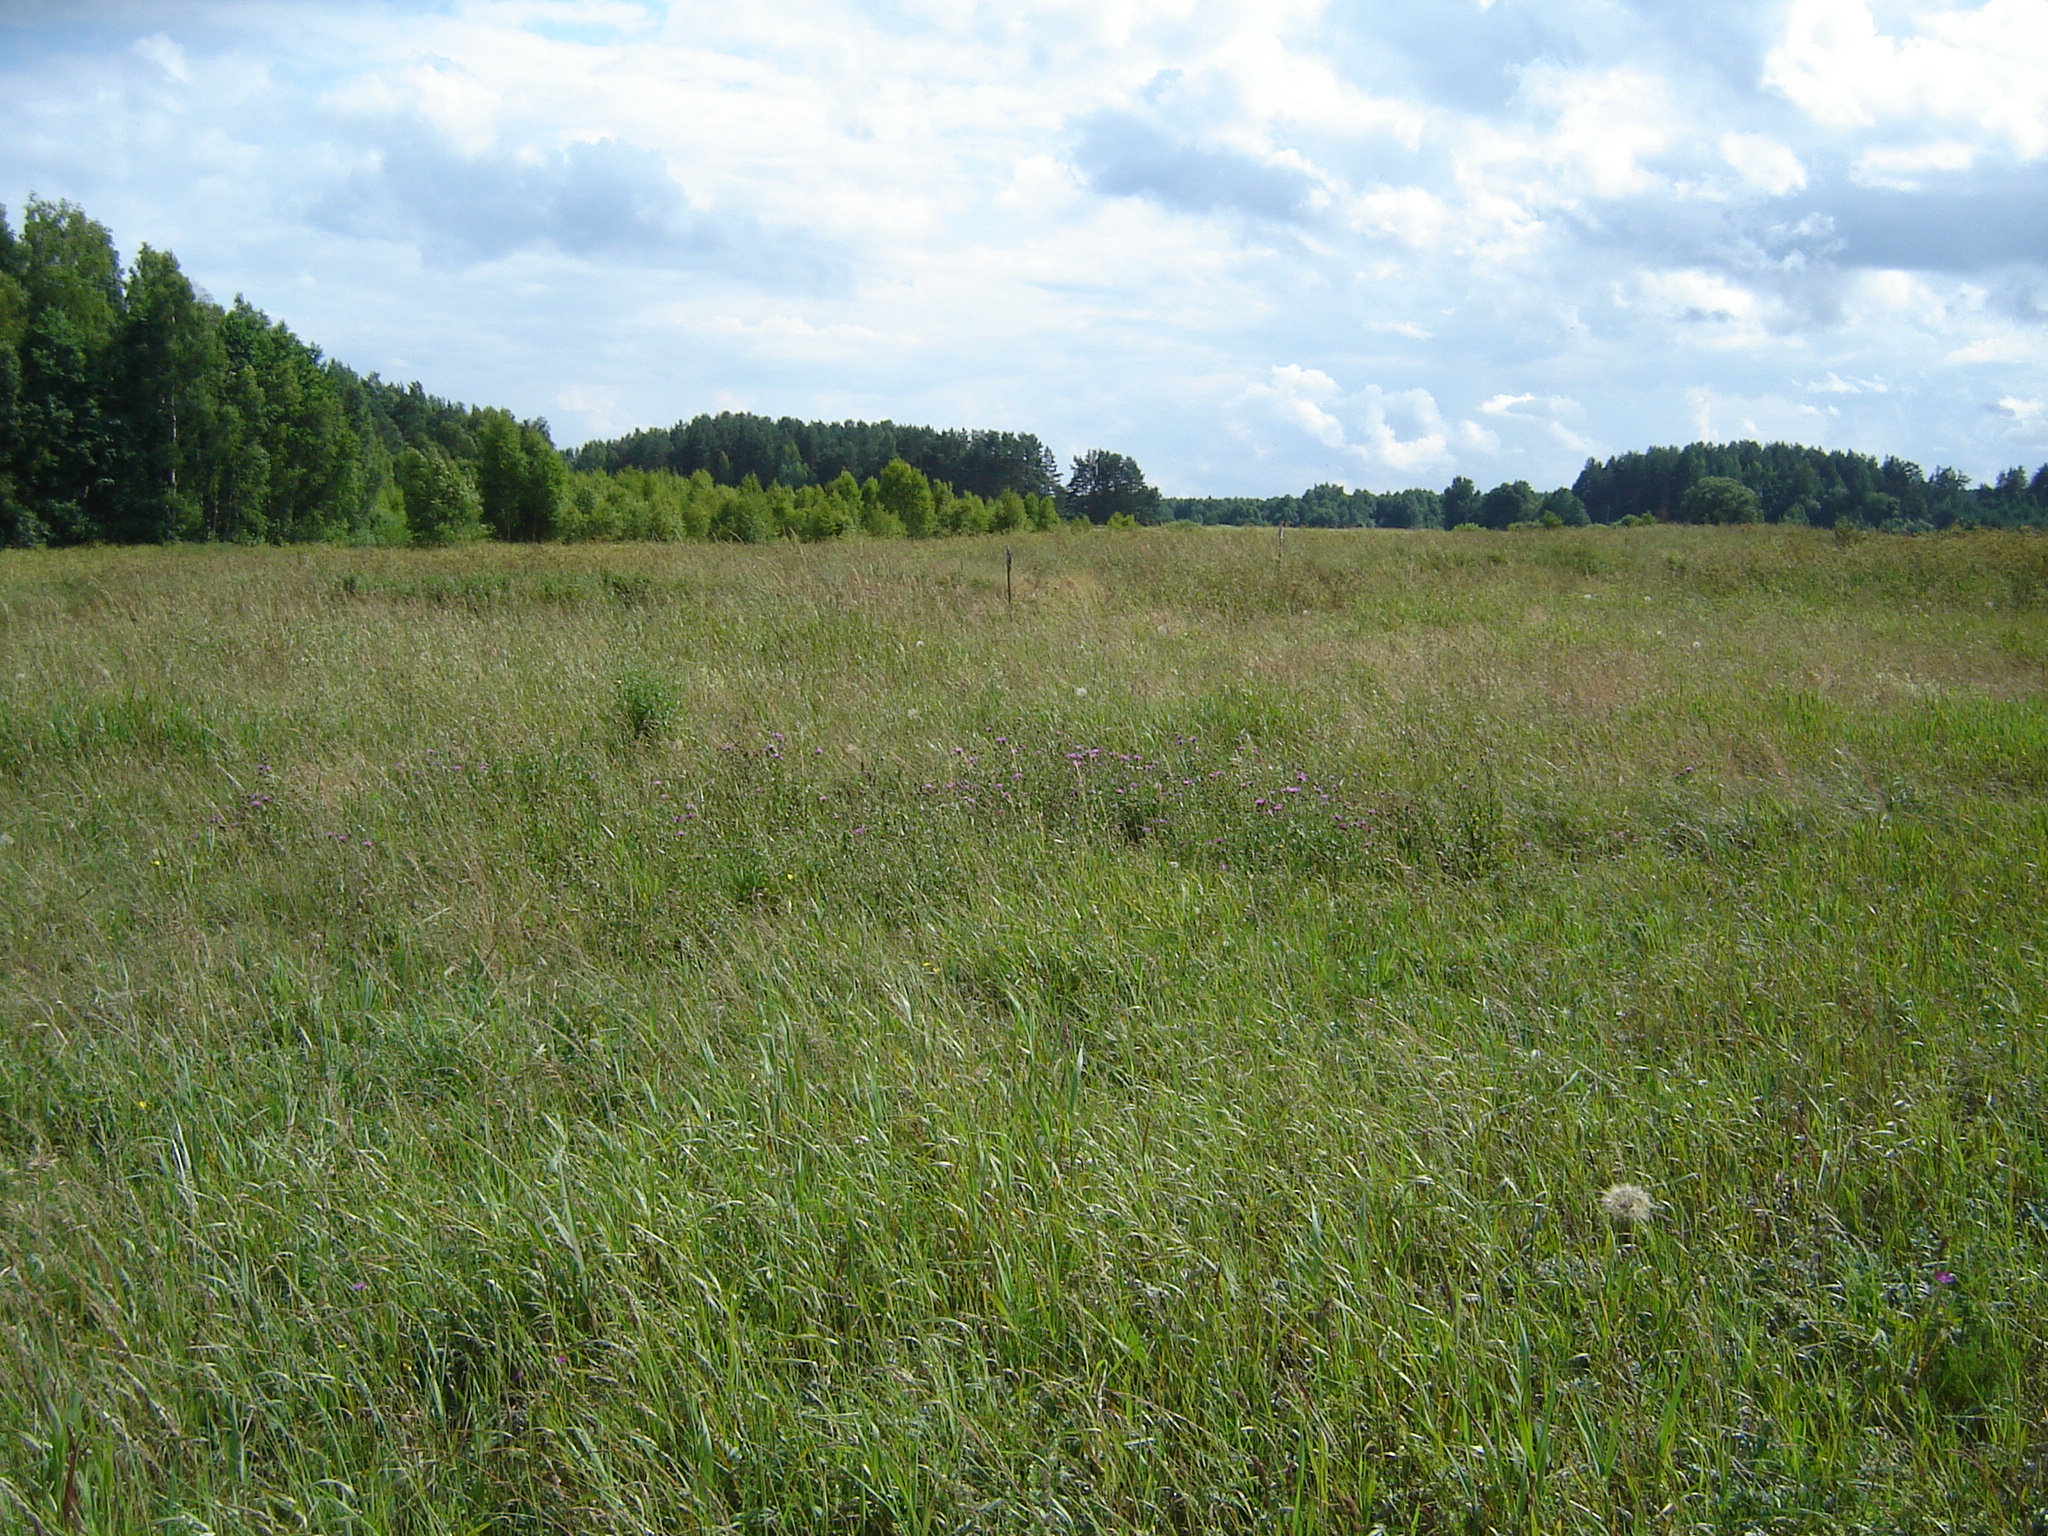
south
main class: Grassland
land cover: Grassland without tree/shrub cover
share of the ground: > 75 %
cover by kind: herbaceous plants 100 %
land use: Agriculture (excluding fallow land and kitchen gardens)
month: July
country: LT
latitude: 55.2425
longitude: 25.4591
